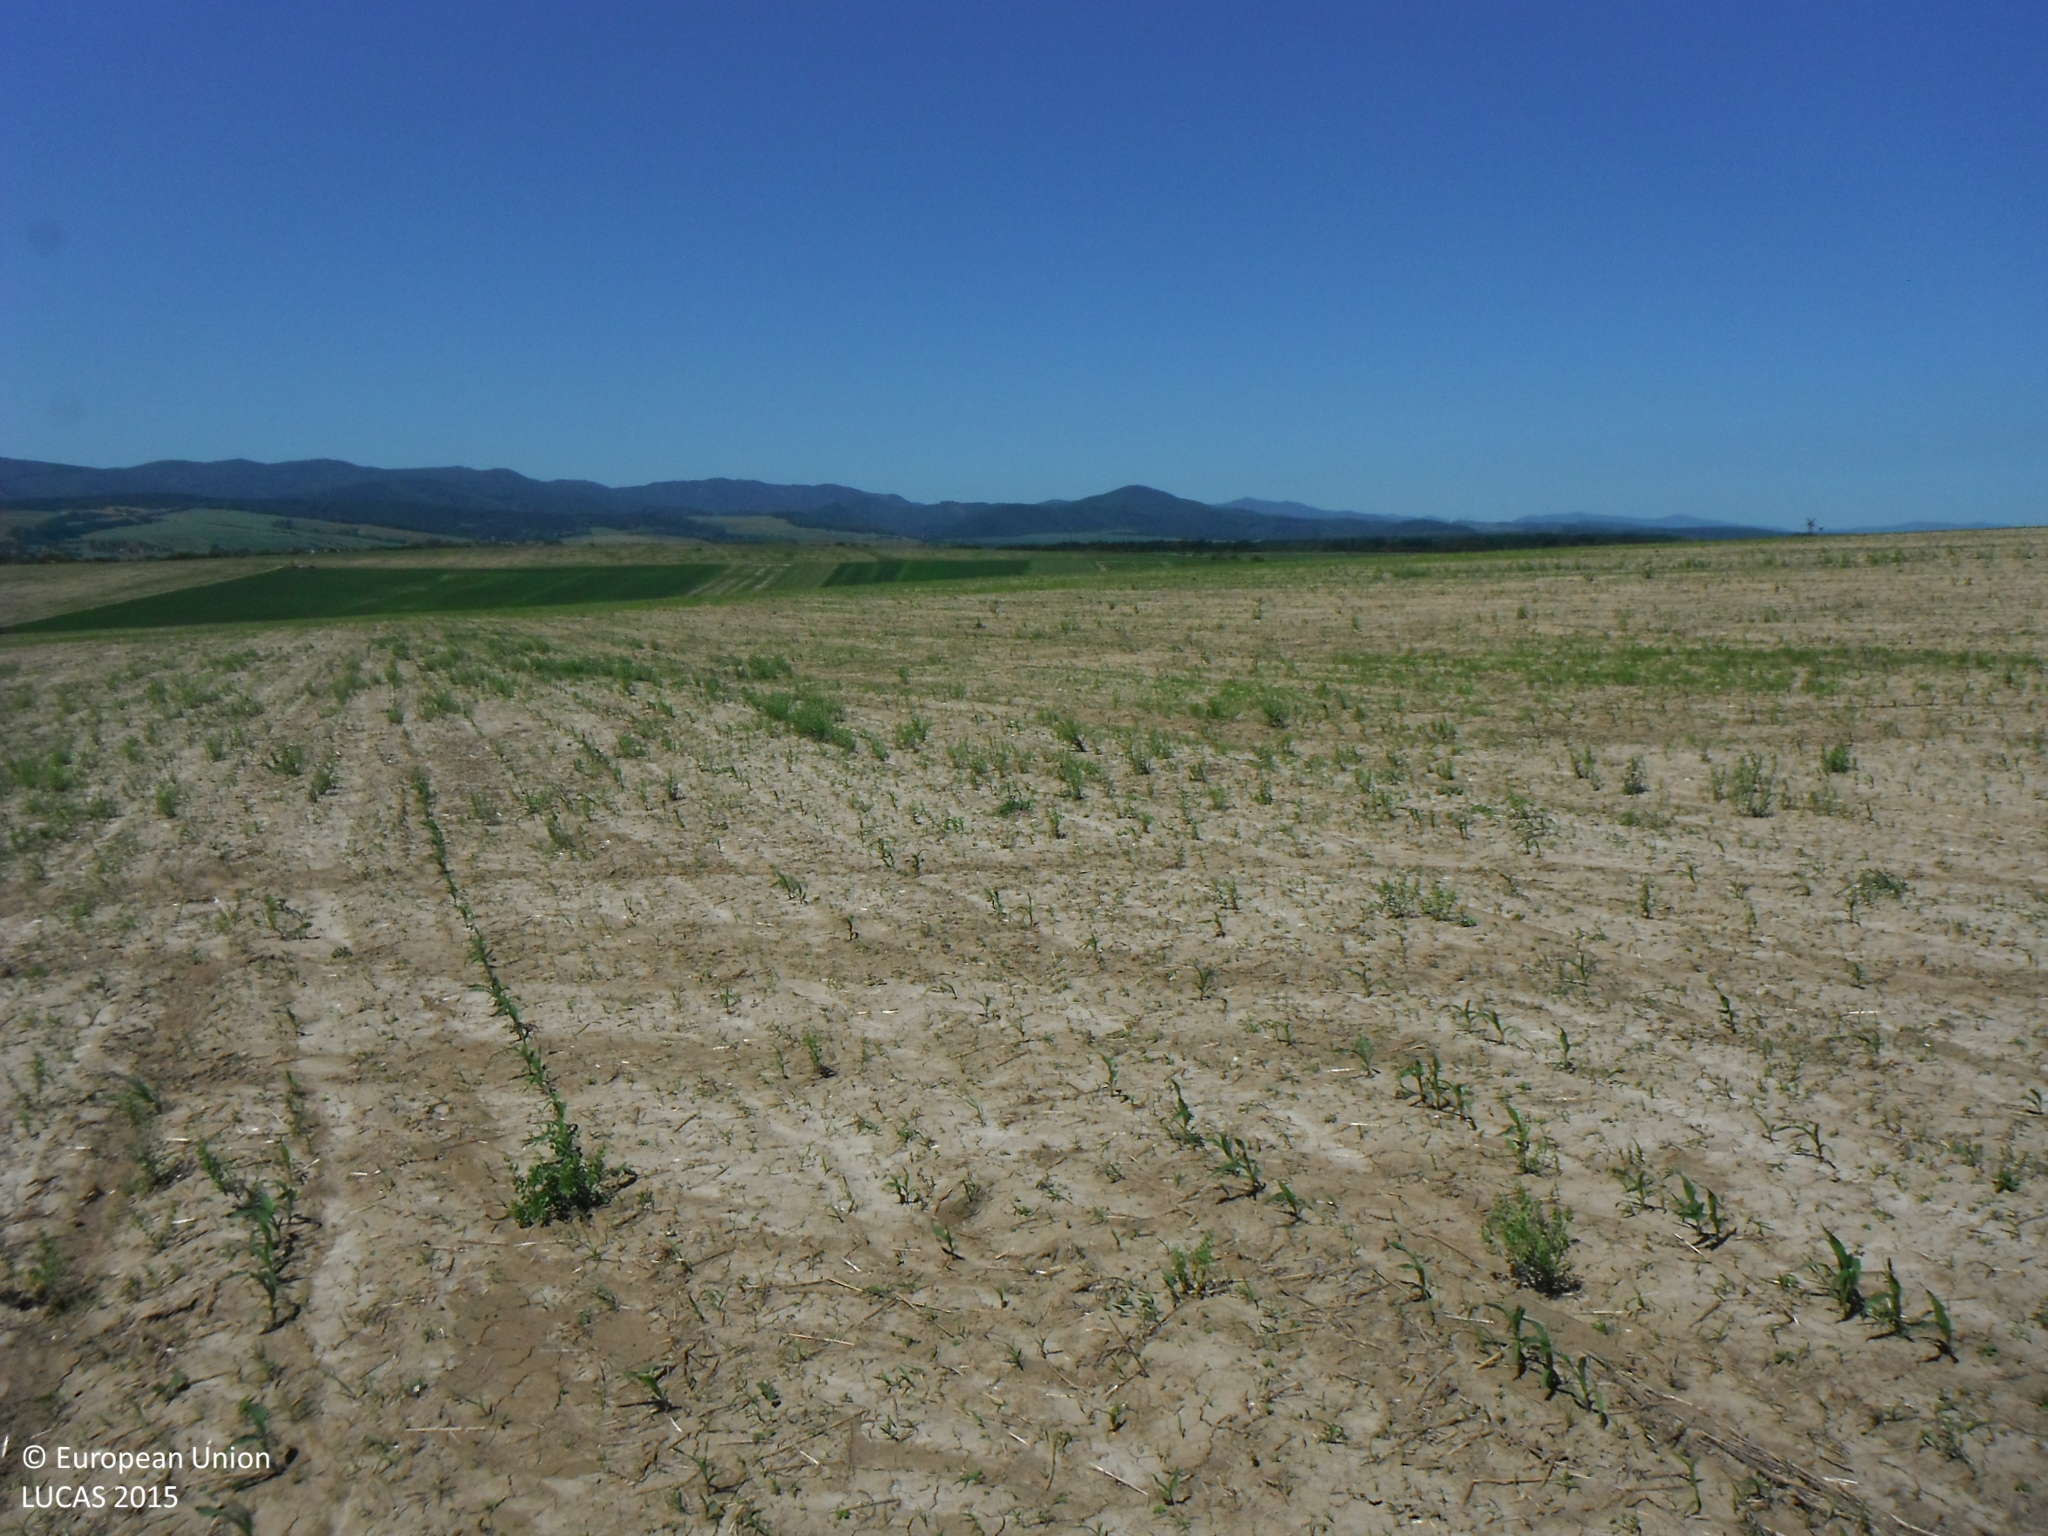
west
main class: Cropland
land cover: Maize
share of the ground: < 10 %
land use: Agriculture (excluding fallow land and kitchen gardens)
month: June
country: SK
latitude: 48.8531
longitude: 21.3442
